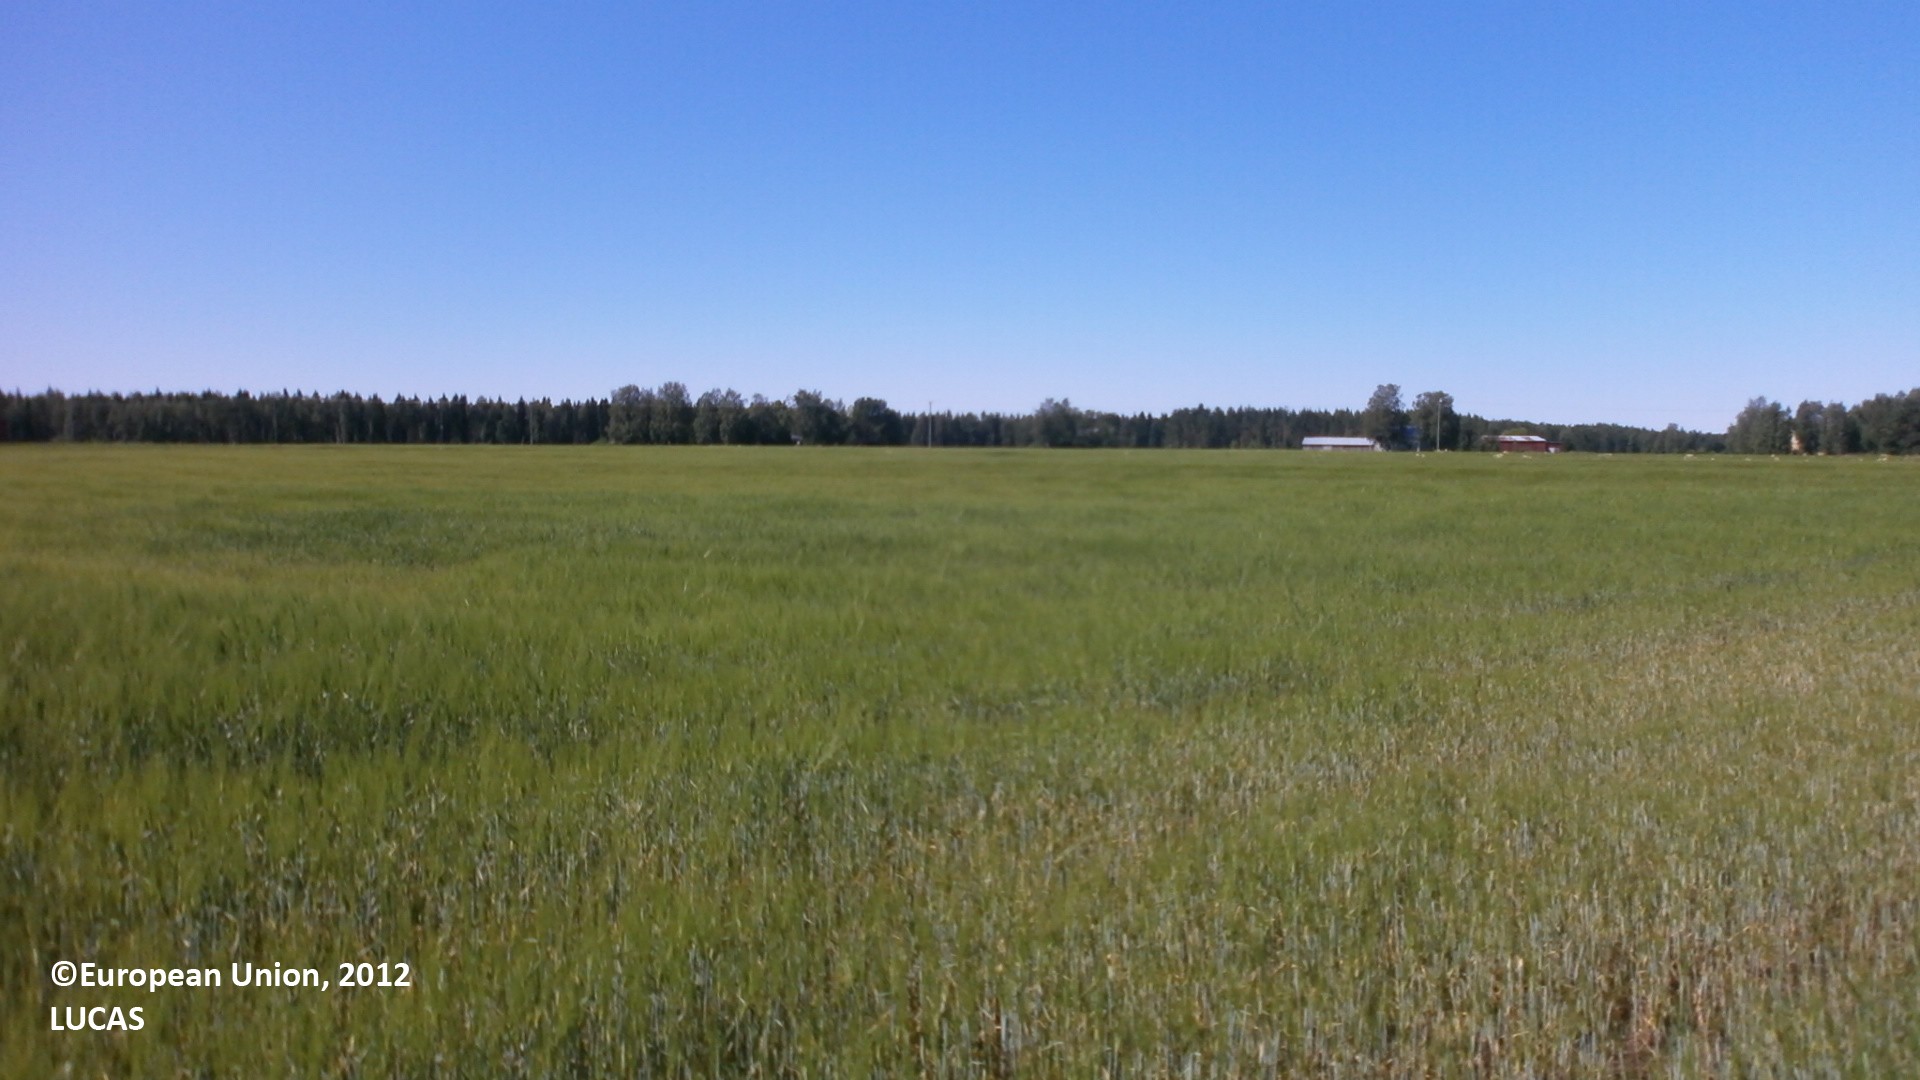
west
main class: Cropland
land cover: Barley
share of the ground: > 75 %
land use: Agriculture (excluding fallow land and kitchen gardens)
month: July
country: FI
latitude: 64.1227
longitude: 23.7992
